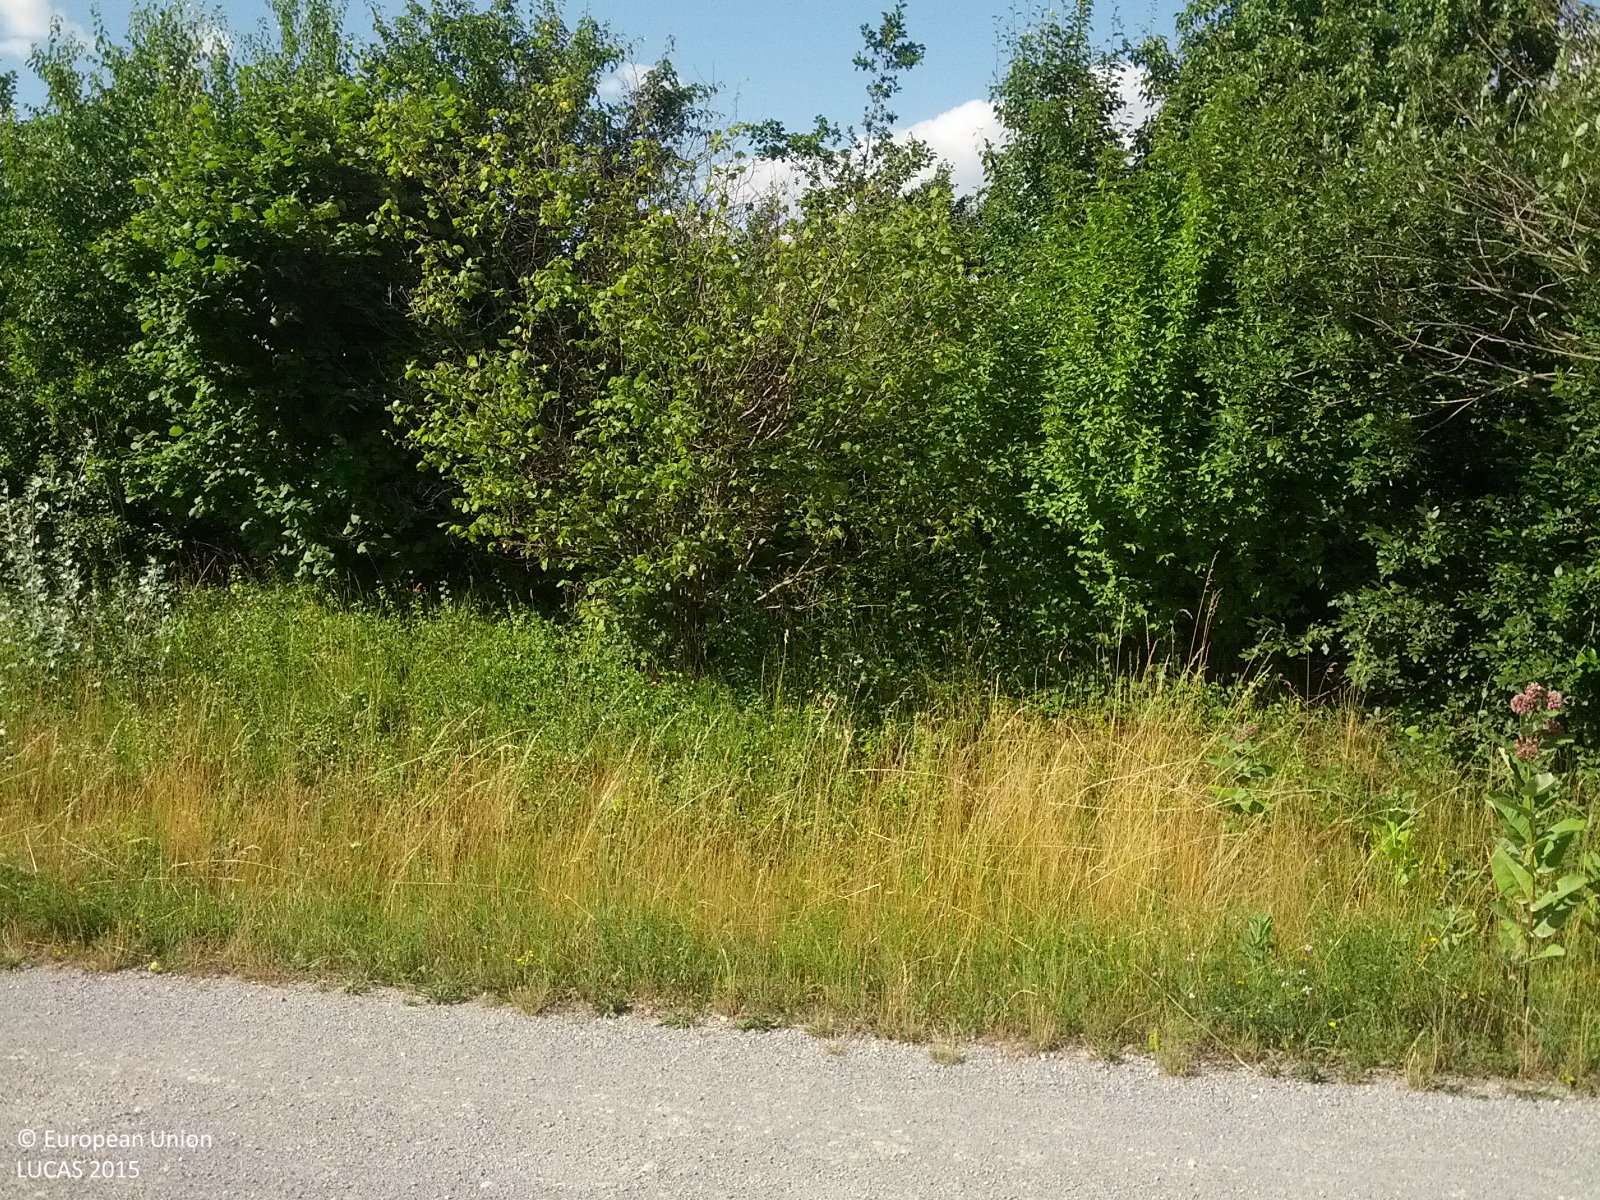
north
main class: Cropland
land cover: Rape and turnip rape
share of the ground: > 75 %
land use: Agriculture (excluding fallow land and kitchen gardens)
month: June
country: AT
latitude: 48.3015
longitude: 16.5171
